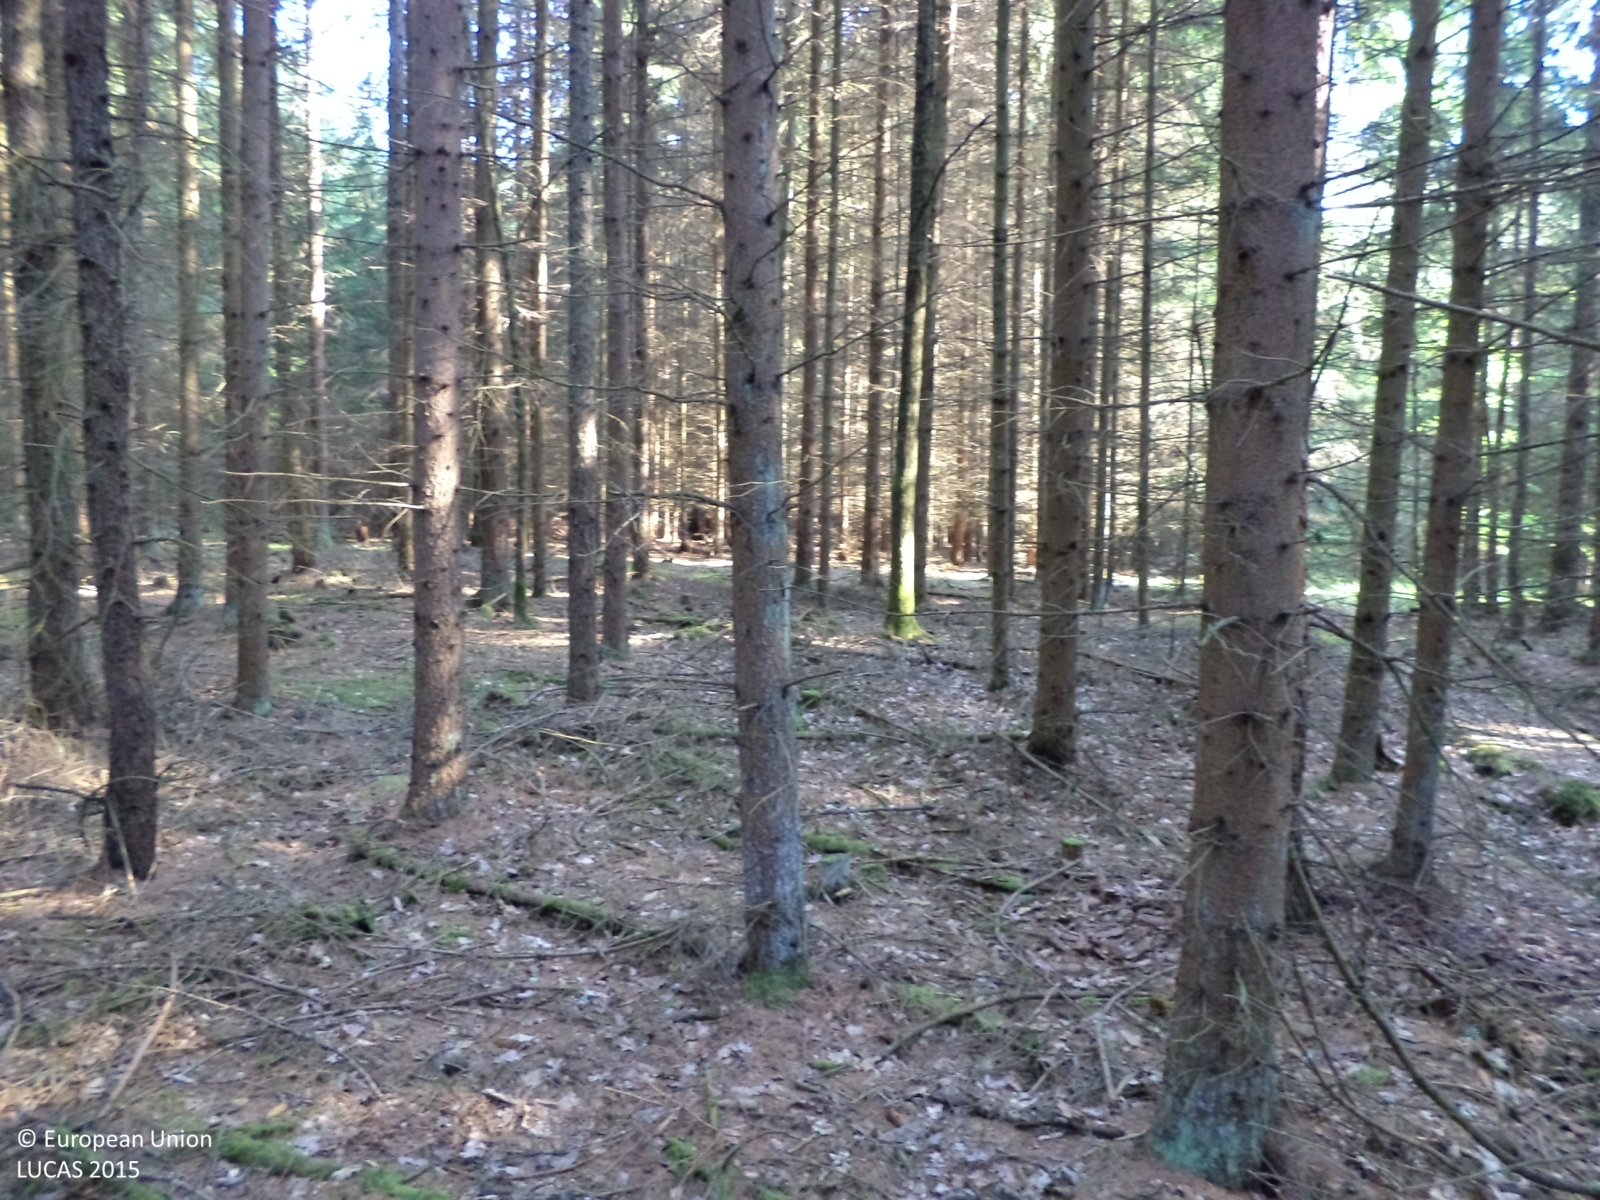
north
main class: Woodland
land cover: Spruce dominated mixed woodland
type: hemiboreal forest and nemoral coniferous forest and mixed broadleaved-coniferous forest
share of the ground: > 75 %
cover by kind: coniferous forest trees 70 %, broadleaved forest trees 25 %, lichens and mosses 5 %
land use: Forestry
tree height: > 5 m
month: June
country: CZ
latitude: 49.2278
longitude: 14.5741
